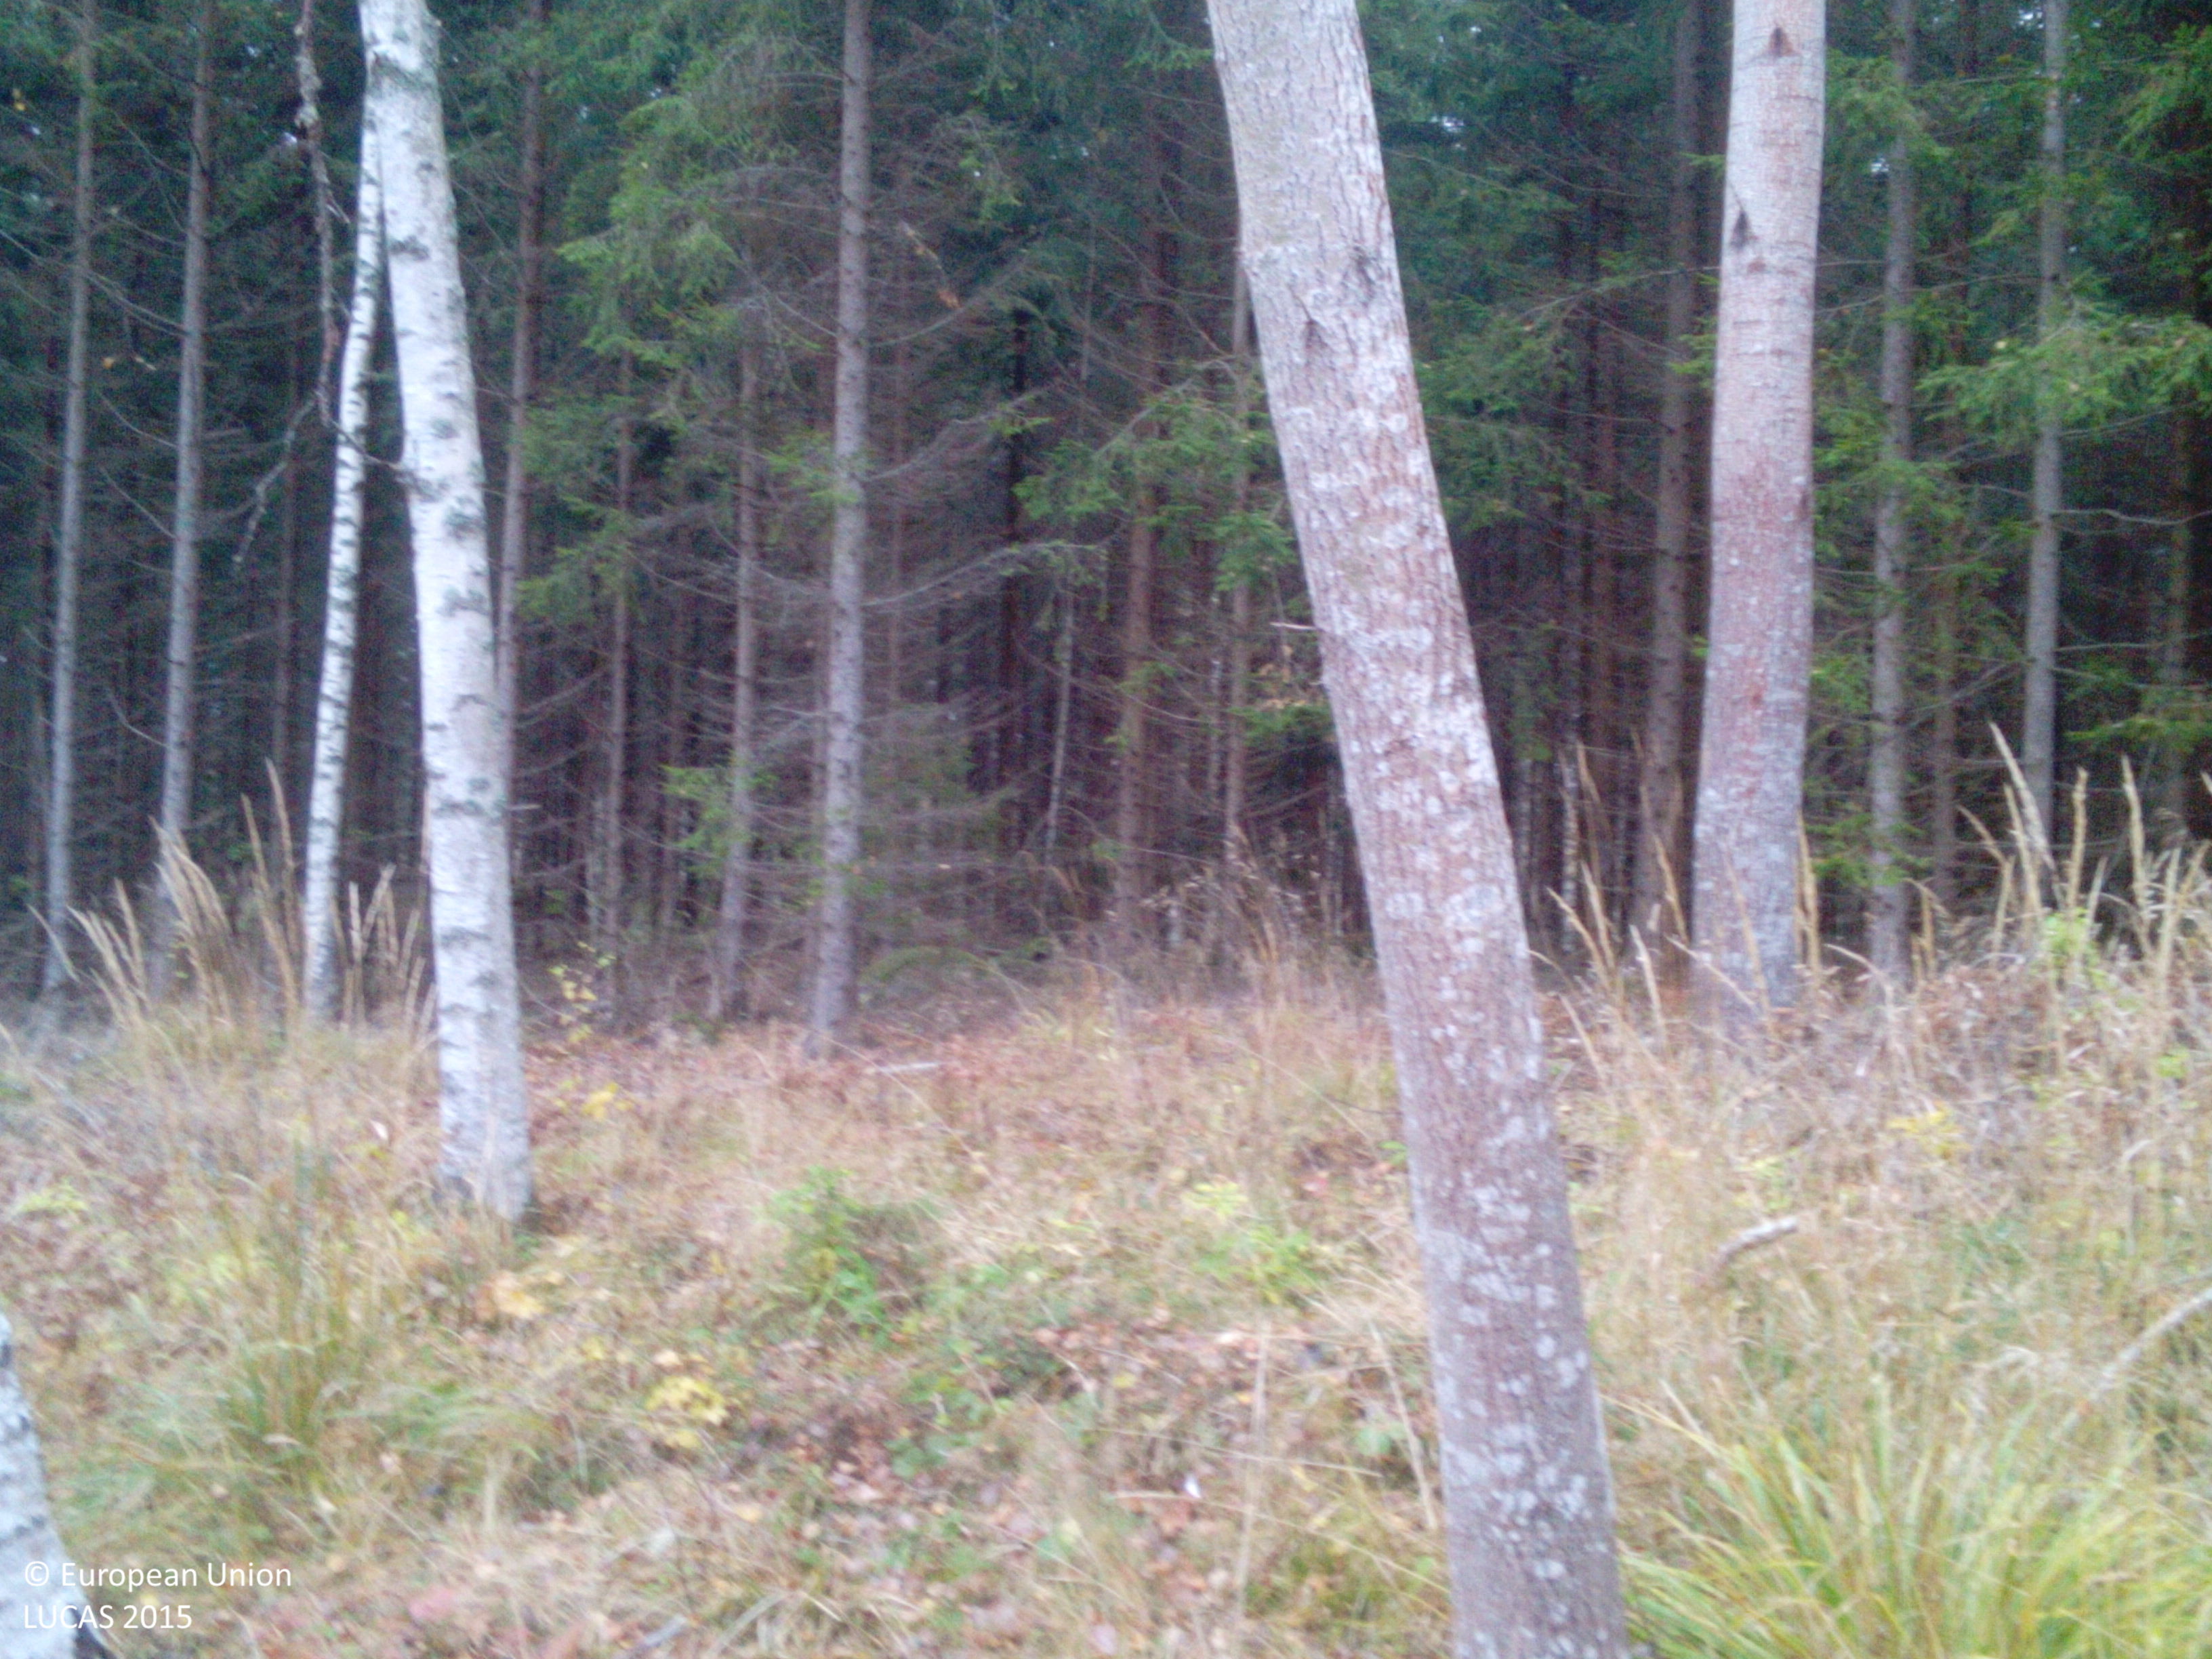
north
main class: Woodland
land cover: Broadleaved woodland
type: hemiboreal forest and nemoral coniferous forest and mixed broadleaved-coniferous forest
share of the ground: > 75 %
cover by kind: broadleaved forest trees 80 %, herbaceous plants 20 %
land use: Forestry
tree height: > 5 m
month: October
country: SE
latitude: 59.0862
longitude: 16.2235
